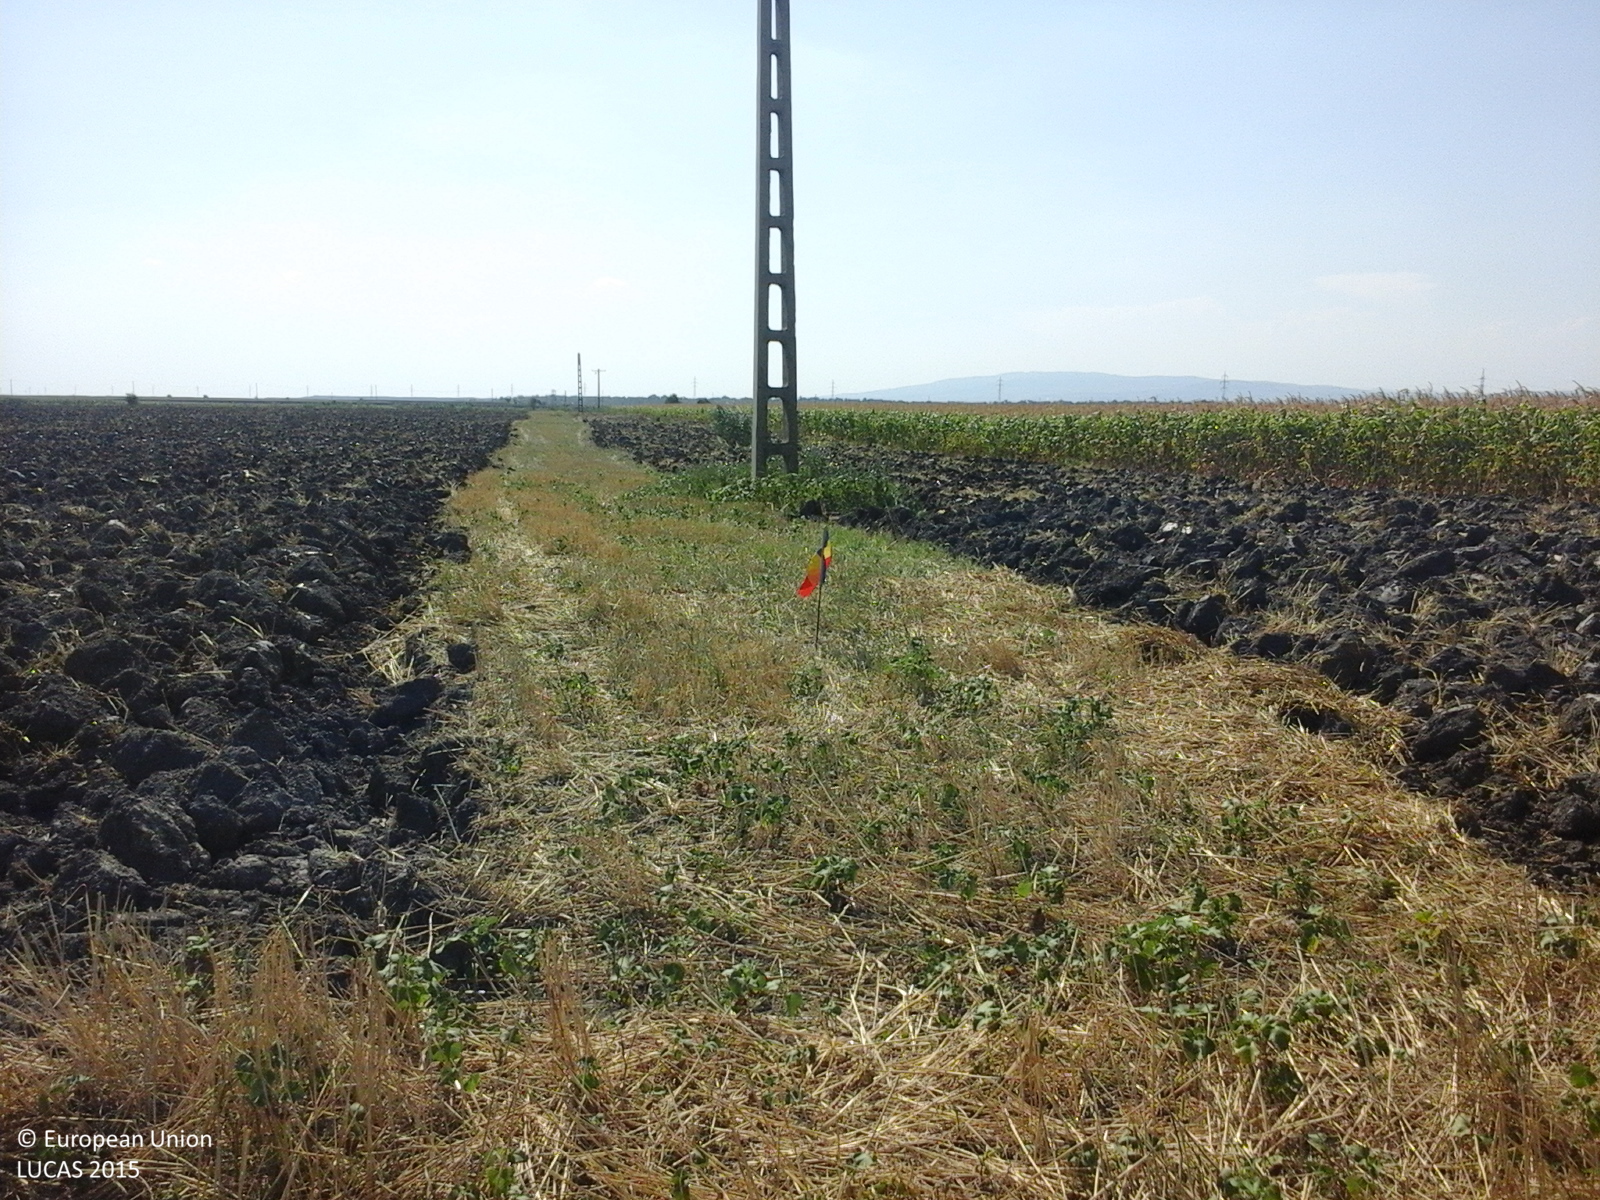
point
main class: Cropland
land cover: Common wheat
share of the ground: < 10 %
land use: Agriculture (excluding fallow land and kitchen gardens)
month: August
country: RO
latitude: 45.0955
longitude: 26.8404
